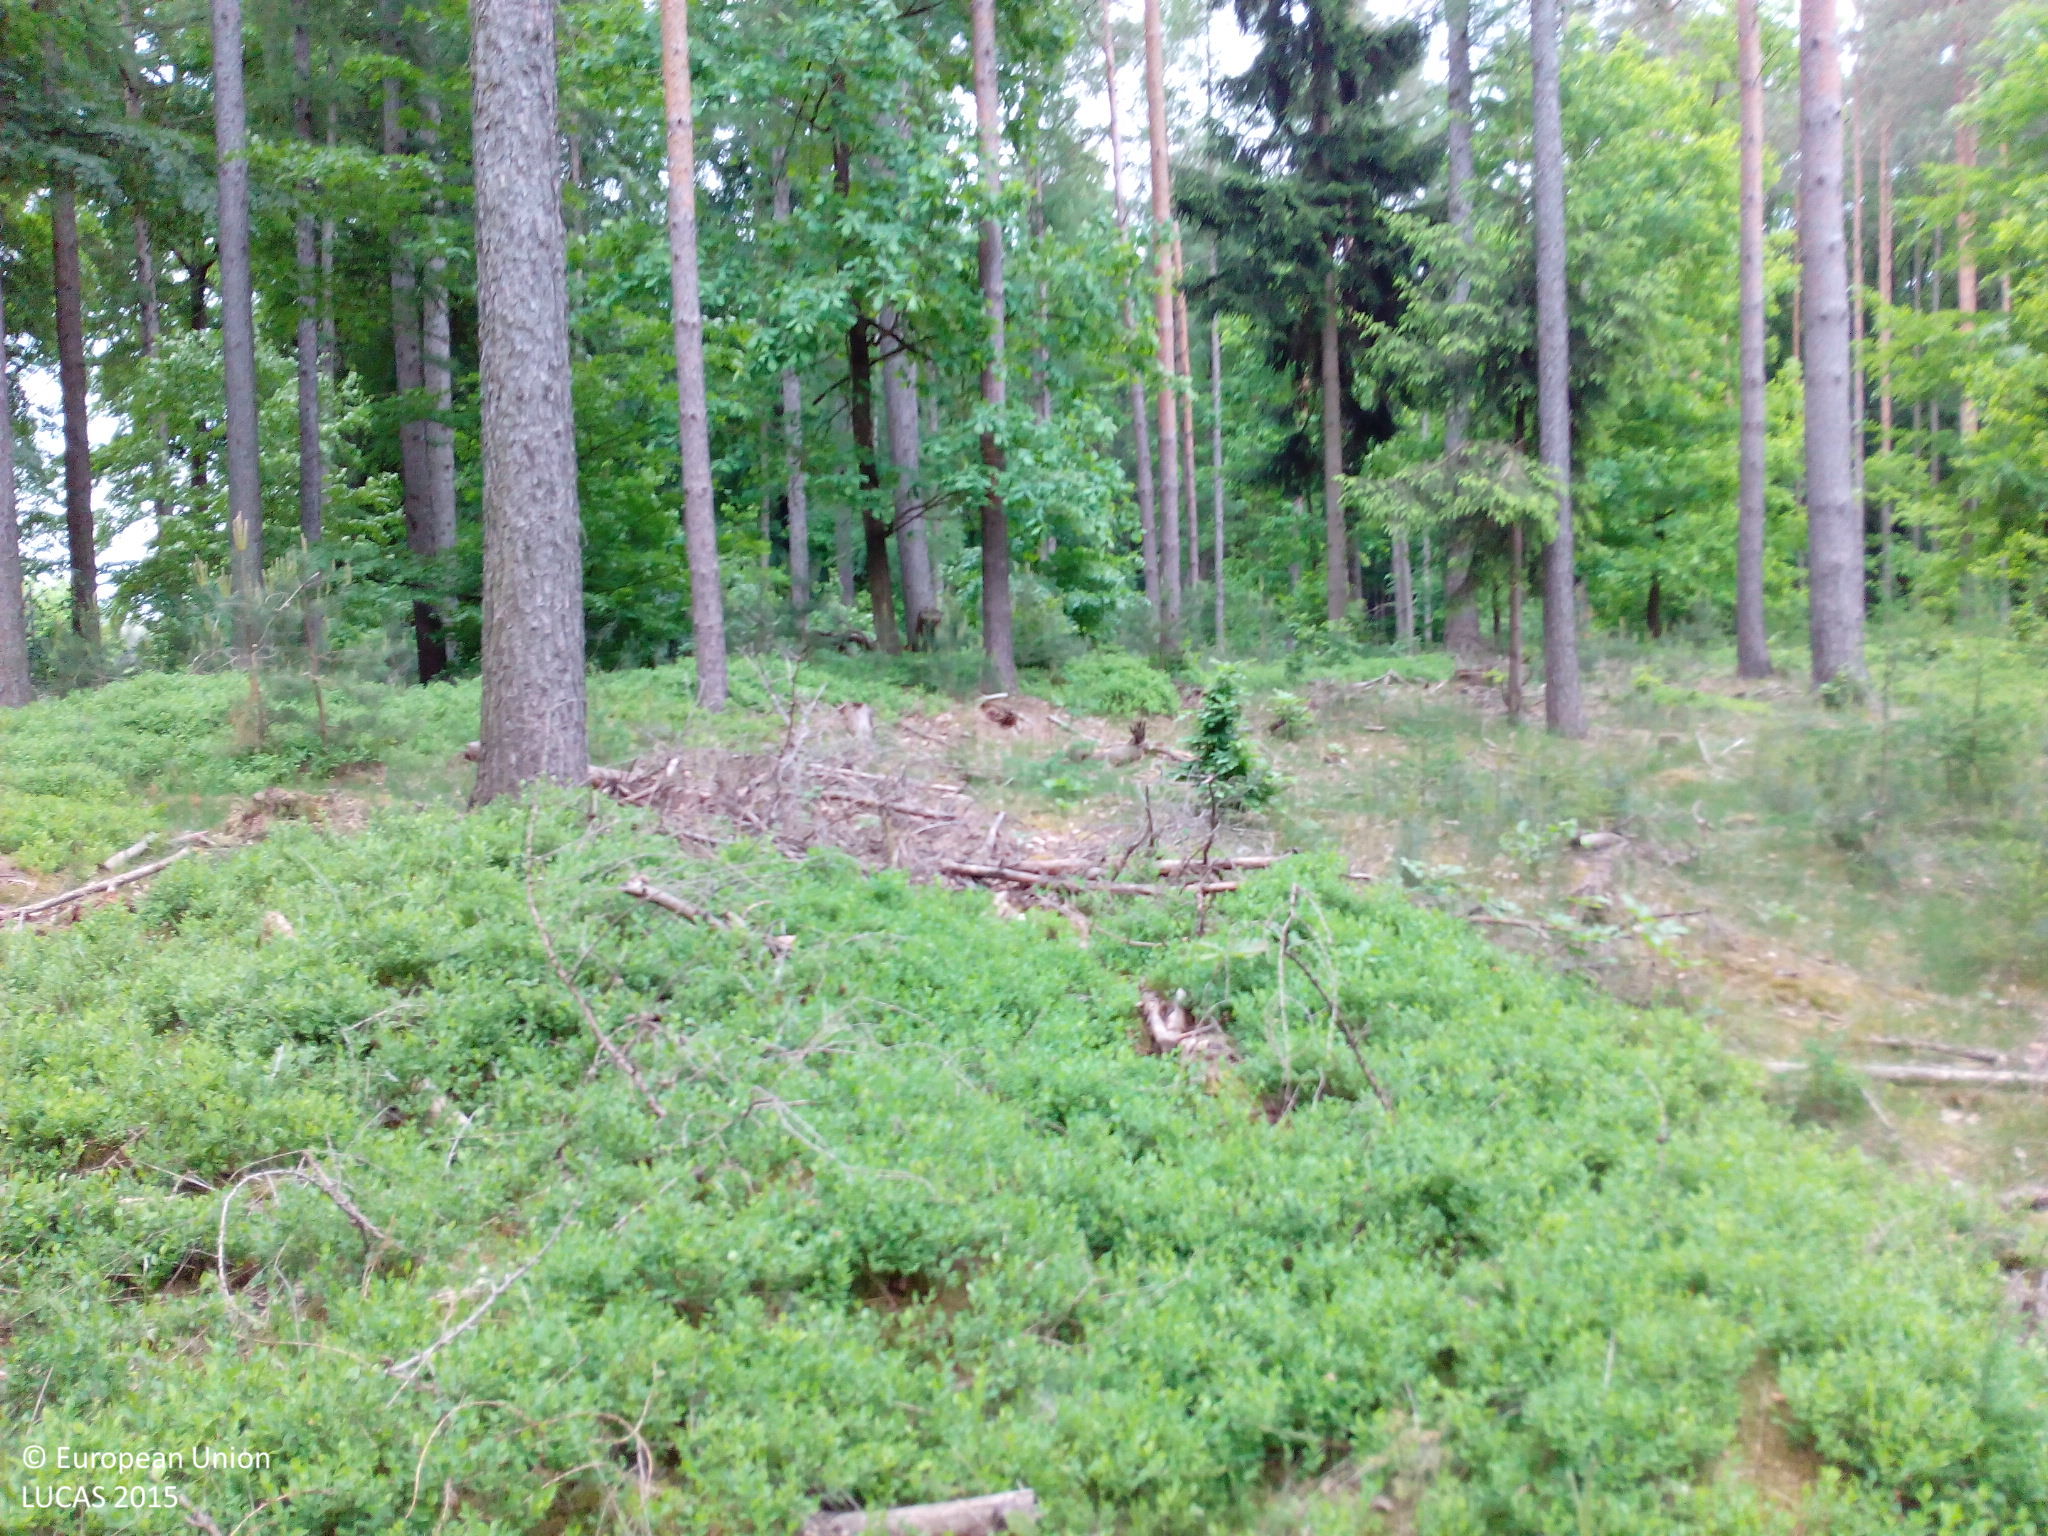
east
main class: Woodland
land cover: Other mixed woodland
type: hemiboreal forest and nemoral coniferous forest and mixed broadleaved-coniferous forest
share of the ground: 50 - 75 %
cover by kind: coniferous forest trees 50 %, broadleaved forest trees 25 %, shrubs 10 %, lichens and mosses 10 %, herbaceous plants 5 %
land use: Forestry
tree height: > 5 m
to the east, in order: Other mixed woodland; Pine dominated mixed woodland; Paved roads, cycling and walking lanes; Fences; Other mixed woodland; Pine dominated mixed woodland
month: May
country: DE
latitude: 52.0648
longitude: 12.4357
